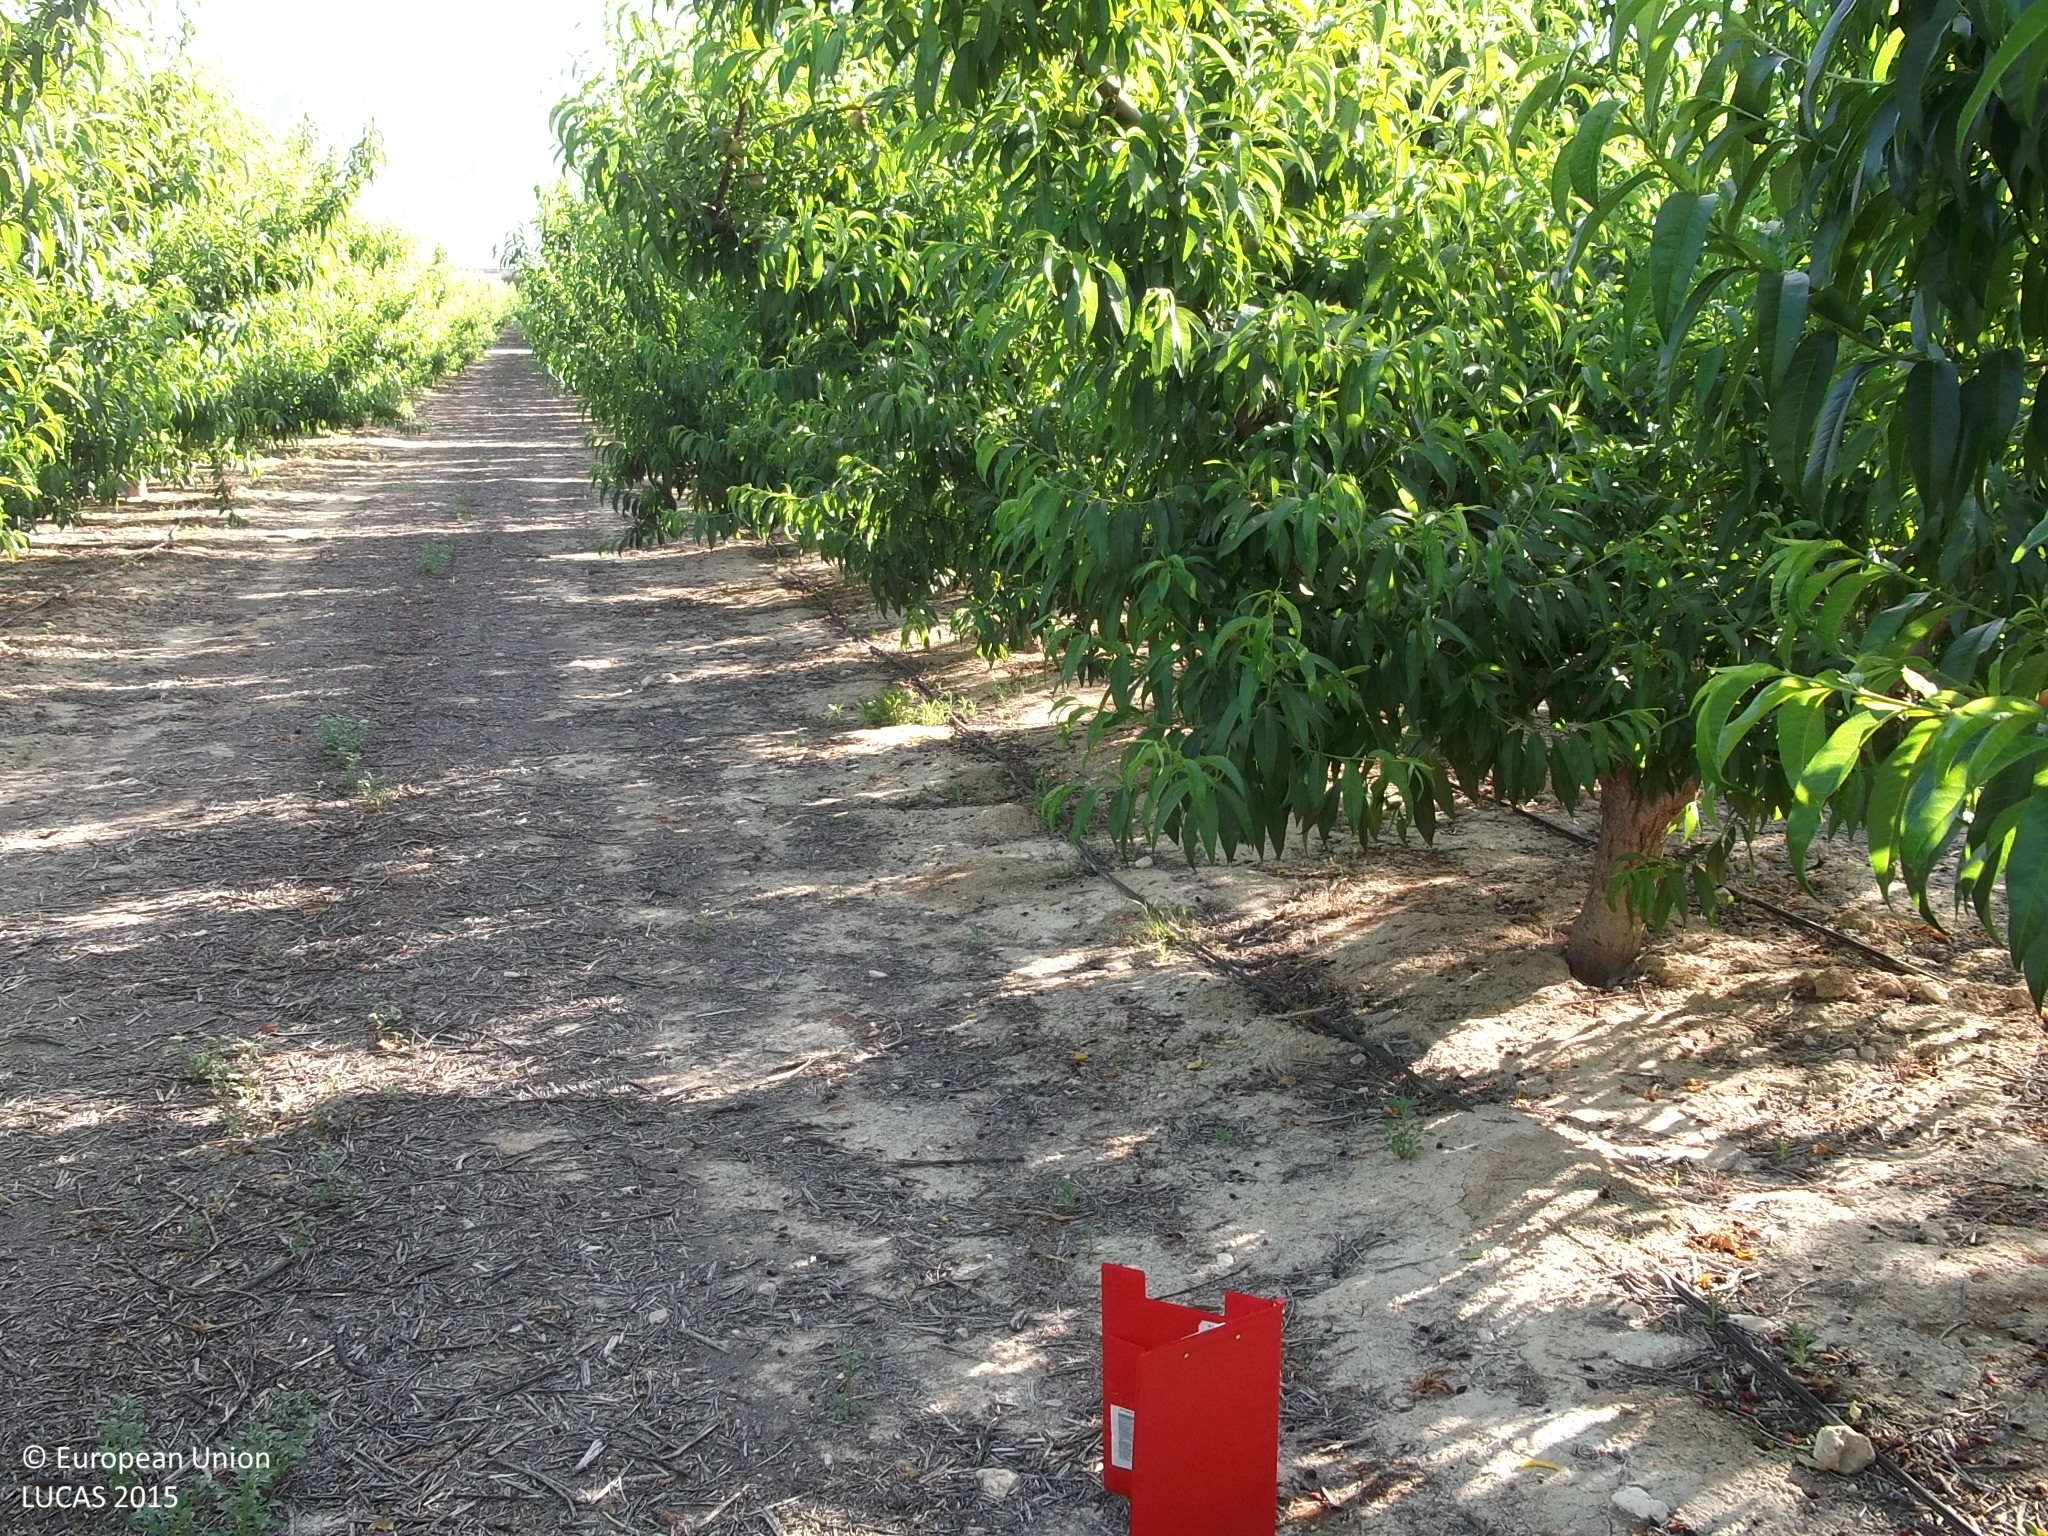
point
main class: Cropland
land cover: Other fruit trees and berries
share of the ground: 25 - 50 %
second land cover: Other bare soil
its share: > 75 %
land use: Agriculture (excluding fallow land and kitchen gardens)
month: May
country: ES
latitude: 38.2052
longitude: -1.3045
